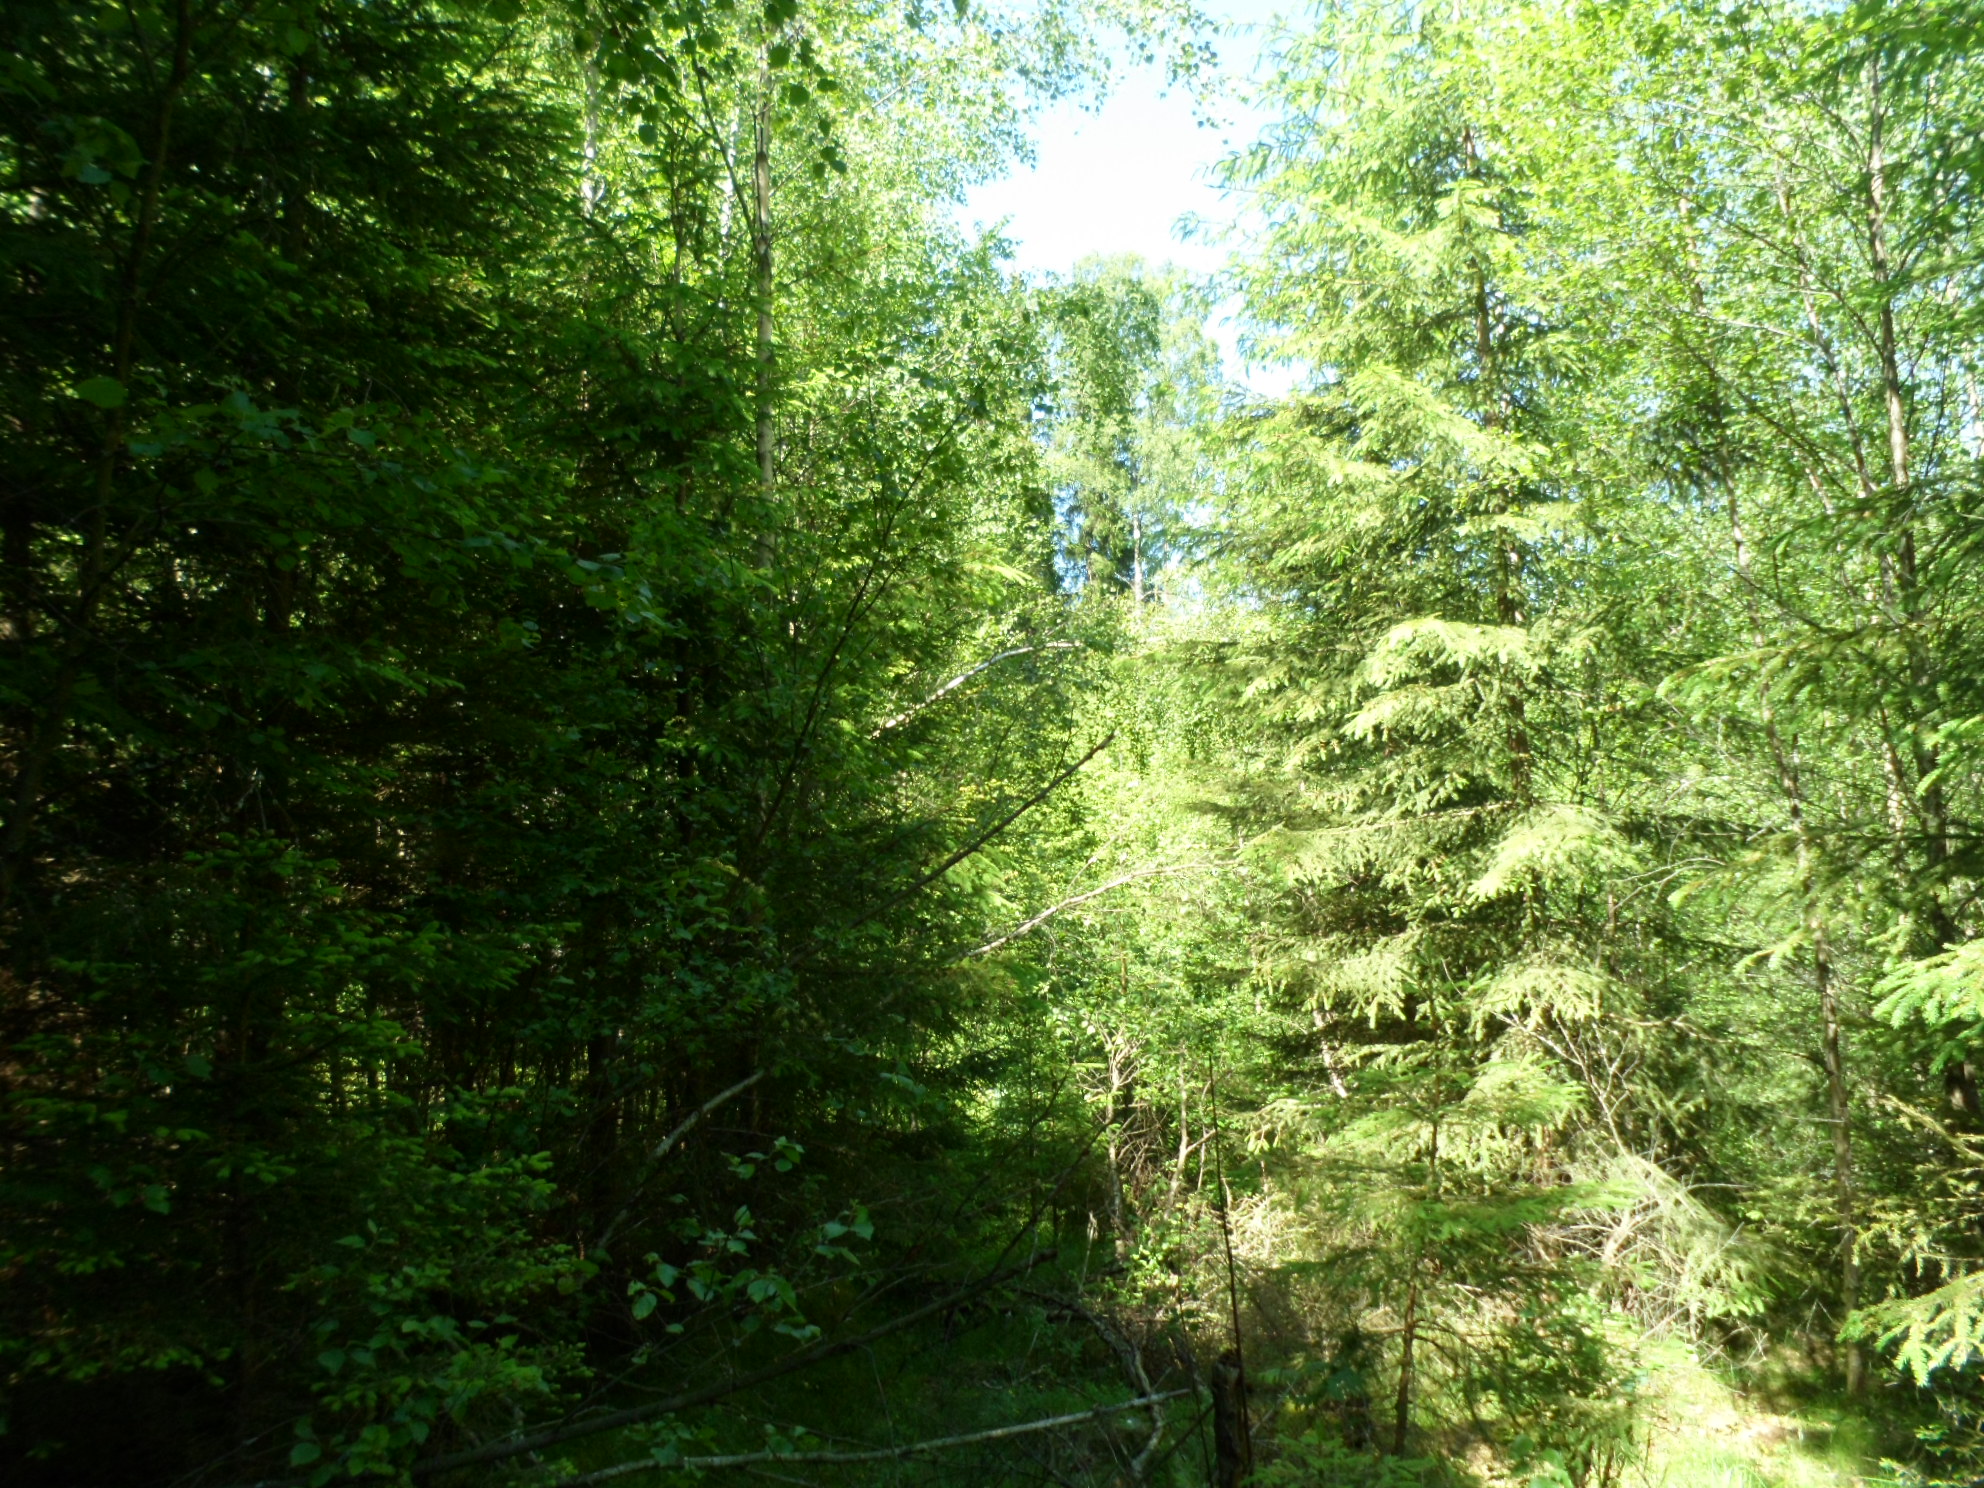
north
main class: Woodland
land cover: Spruce dominated mixed woodland
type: boreal forest
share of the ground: 50 - 75 %
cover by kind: coniferous forest trees 45 %, broadleaved forest trees 20 %, herbaceous plants 15 %, shrubs 10 %, lichens and mosses 10 %
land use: Forestry
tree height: > 5 m
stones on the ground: > 50 %
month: July
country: SE
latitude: 57.4749
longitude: 14.5816
